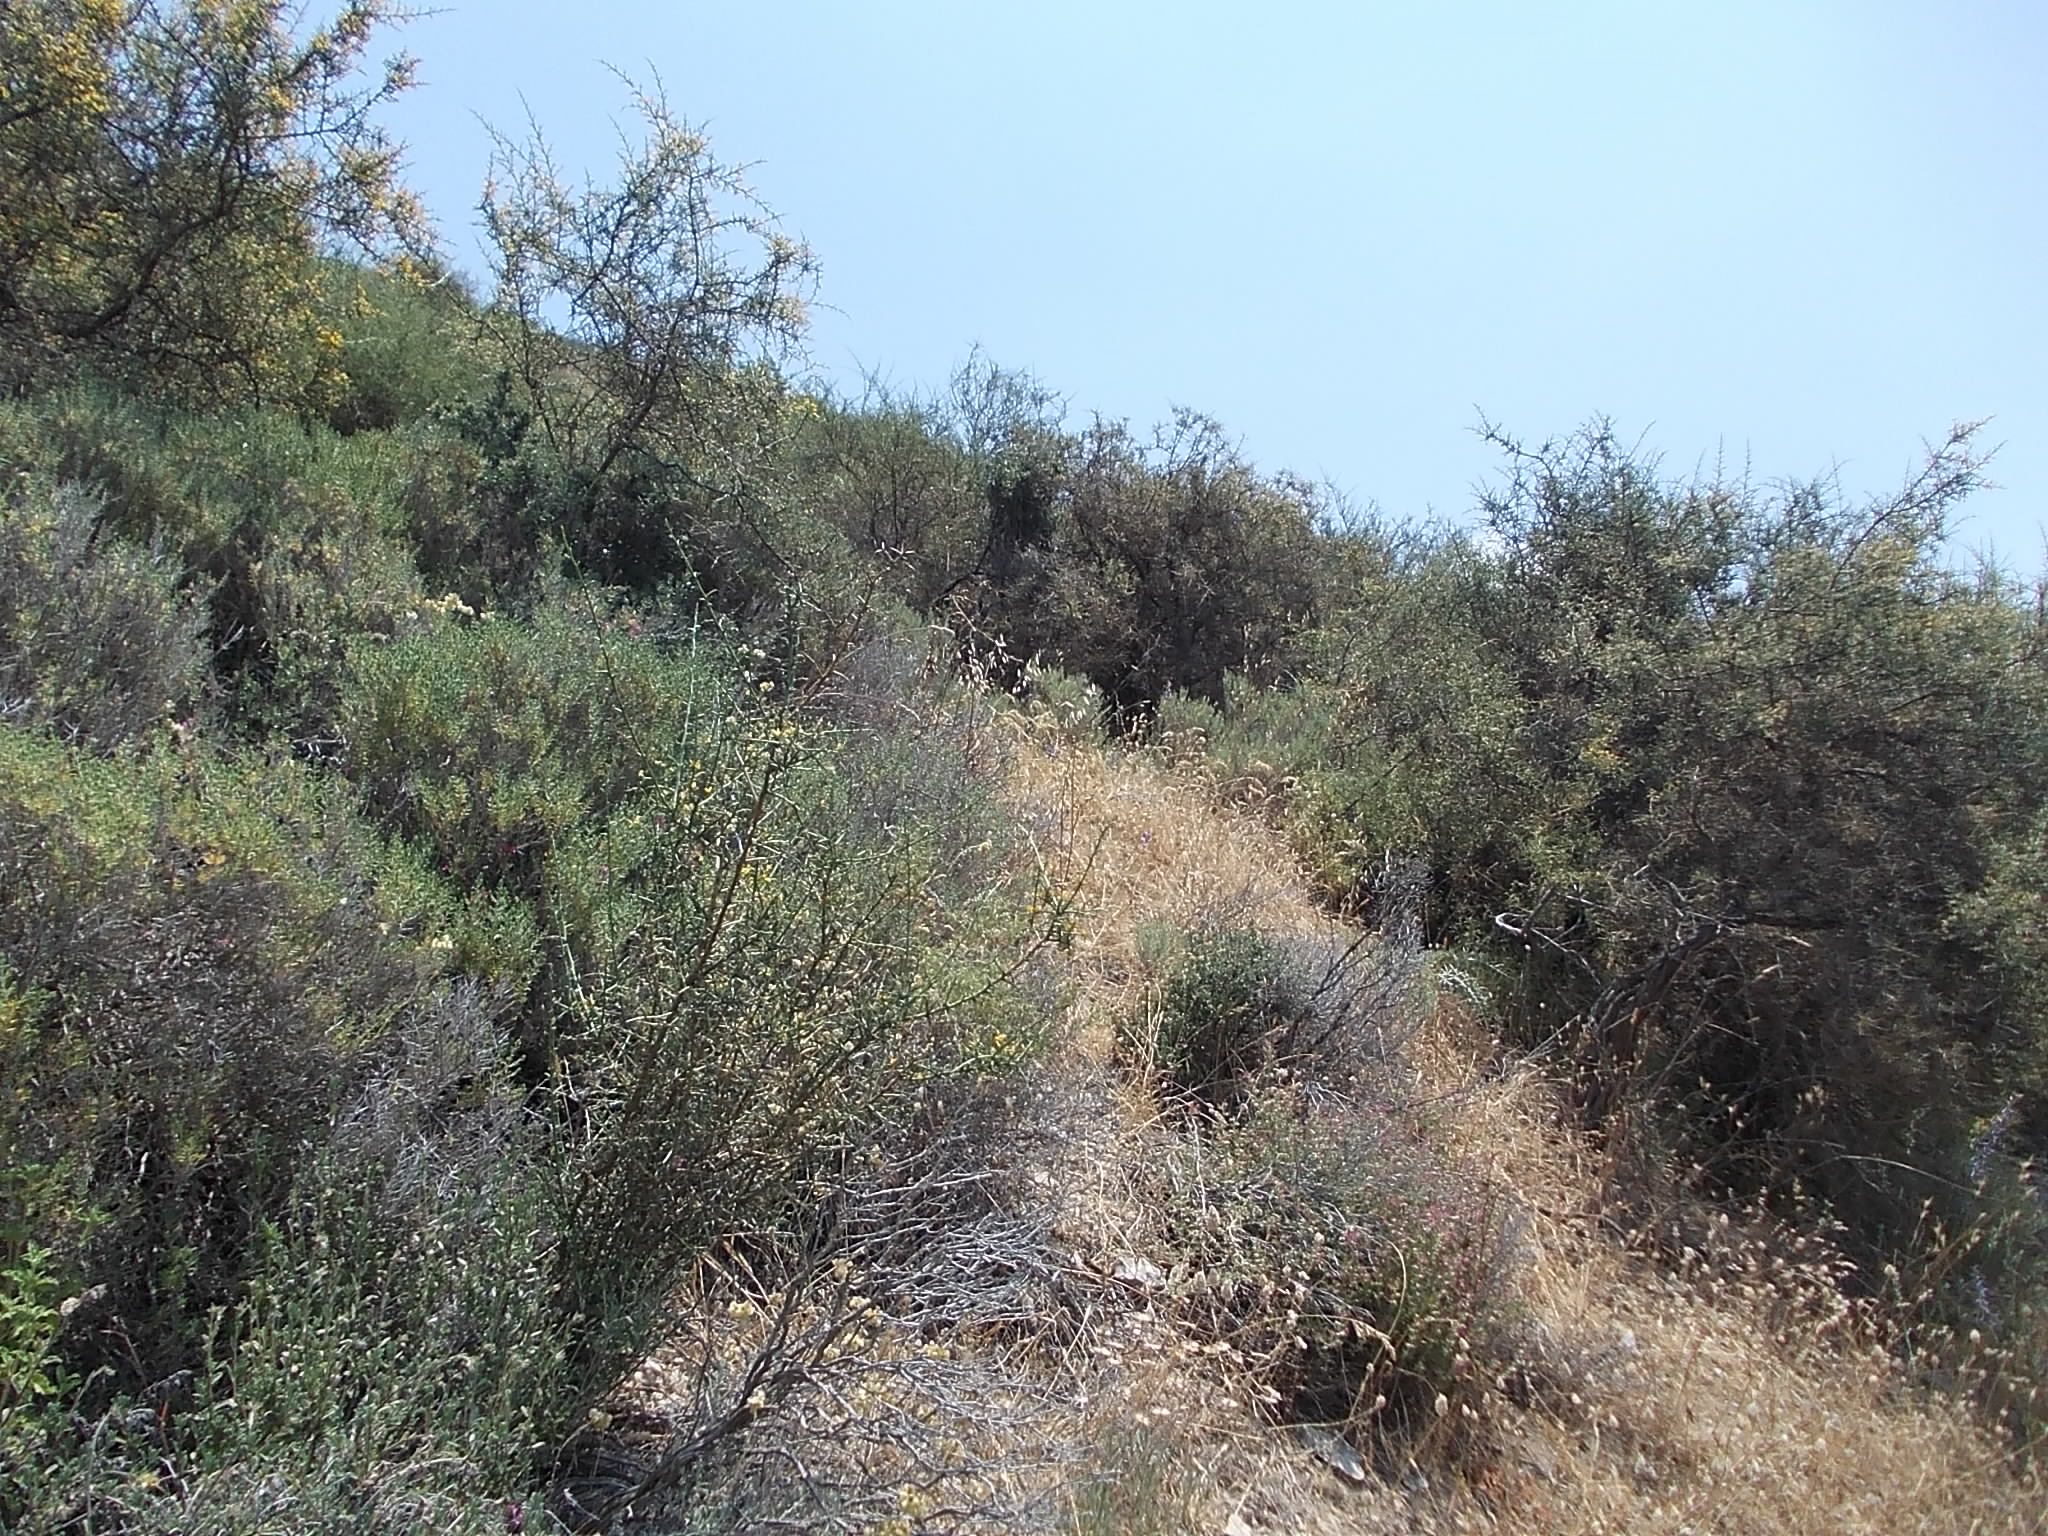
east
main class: Shrubland
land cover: Shrubland without tree cover
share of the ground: > 75 %
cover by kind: shrubs 85 %, herbaceous plants 10 %, unconsolidated bare surface 5 %
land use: Semi-natural and natural areas not in use
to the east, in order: Shrubland without tree cover; Dry stone walls; Shrubland with sparse tree cover; Shrubland without tree cover; Paved roads, cycling and walking lanes; Shrubland without tree cover; Permanent industrial crops; Dry stone walls; Permanent industrial crops; Grassland without tree/shrub cover; Tracks; Grassland without tree/shrub cover; Dry stone walls; Permanent industrial crops; Grassland without tree/shrub cover
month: June
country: CY
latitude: 34.7931
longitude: 32.9300
